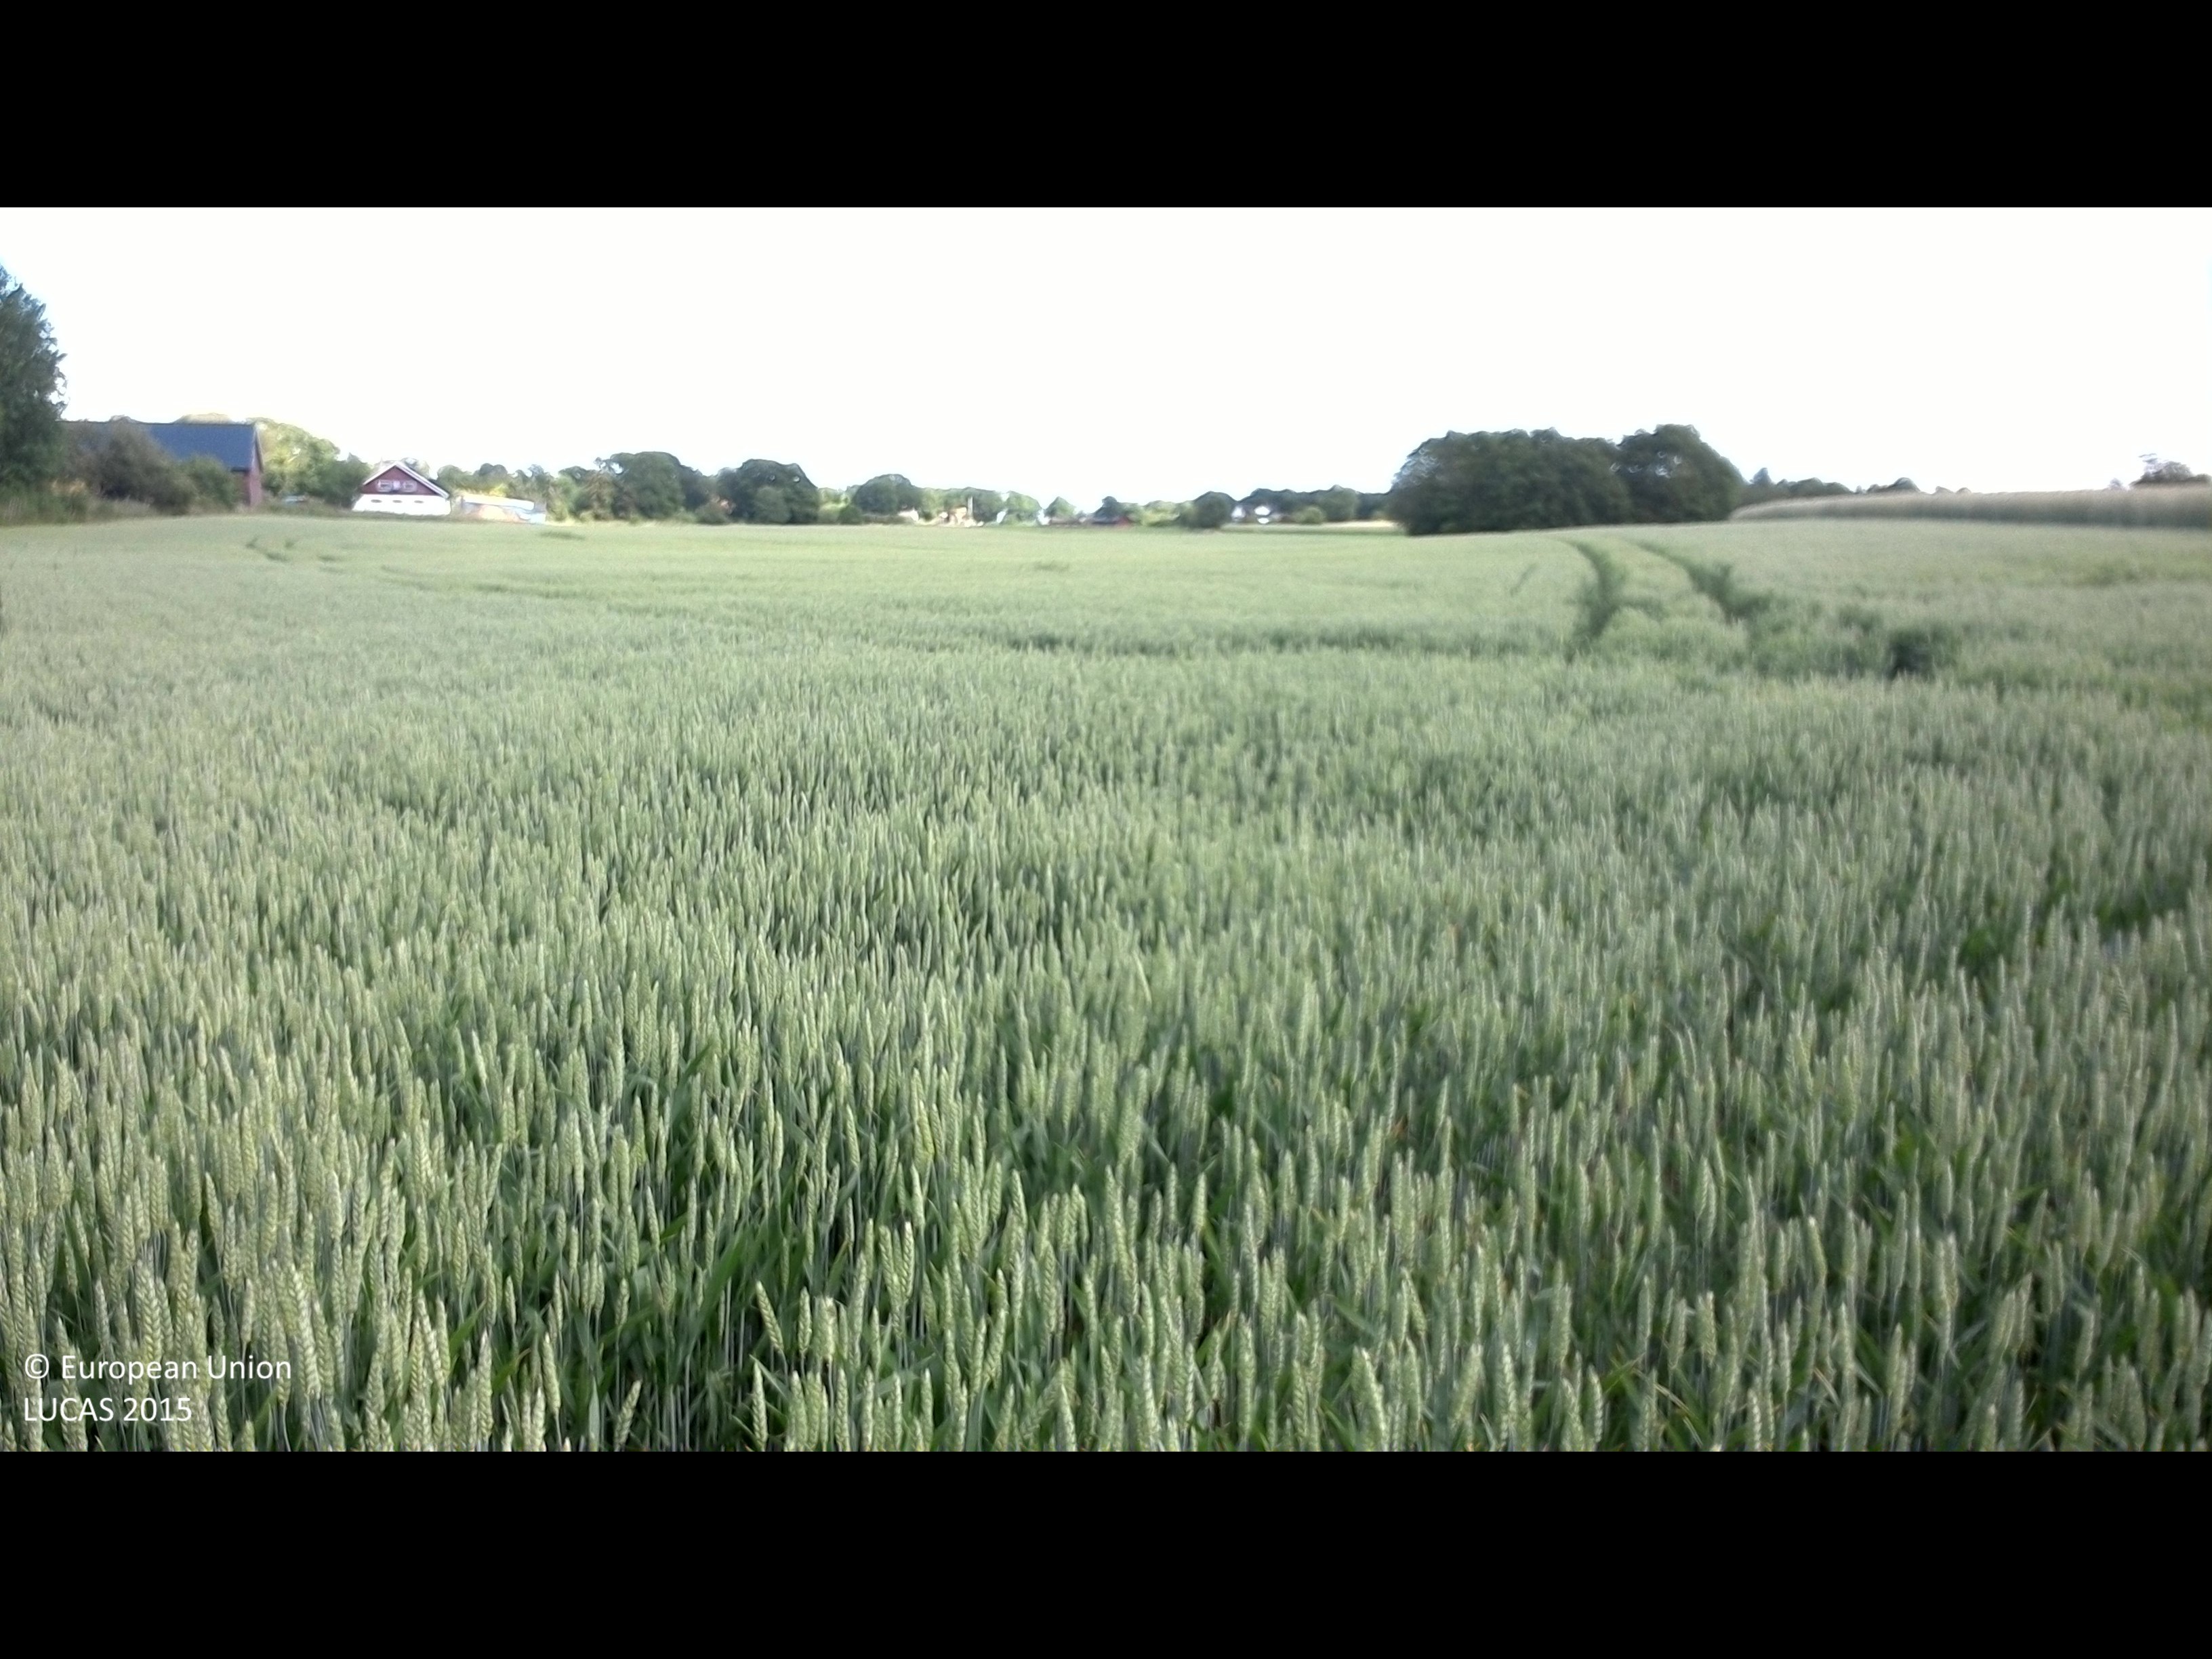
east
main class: Cropland
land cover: Common wheat
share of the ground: > 75 %
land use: Agriculture (excluding fallow land and kitchen gardens)
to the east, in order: Common wheat
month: June
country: SE
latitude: 56.4045
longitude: 16.0774
